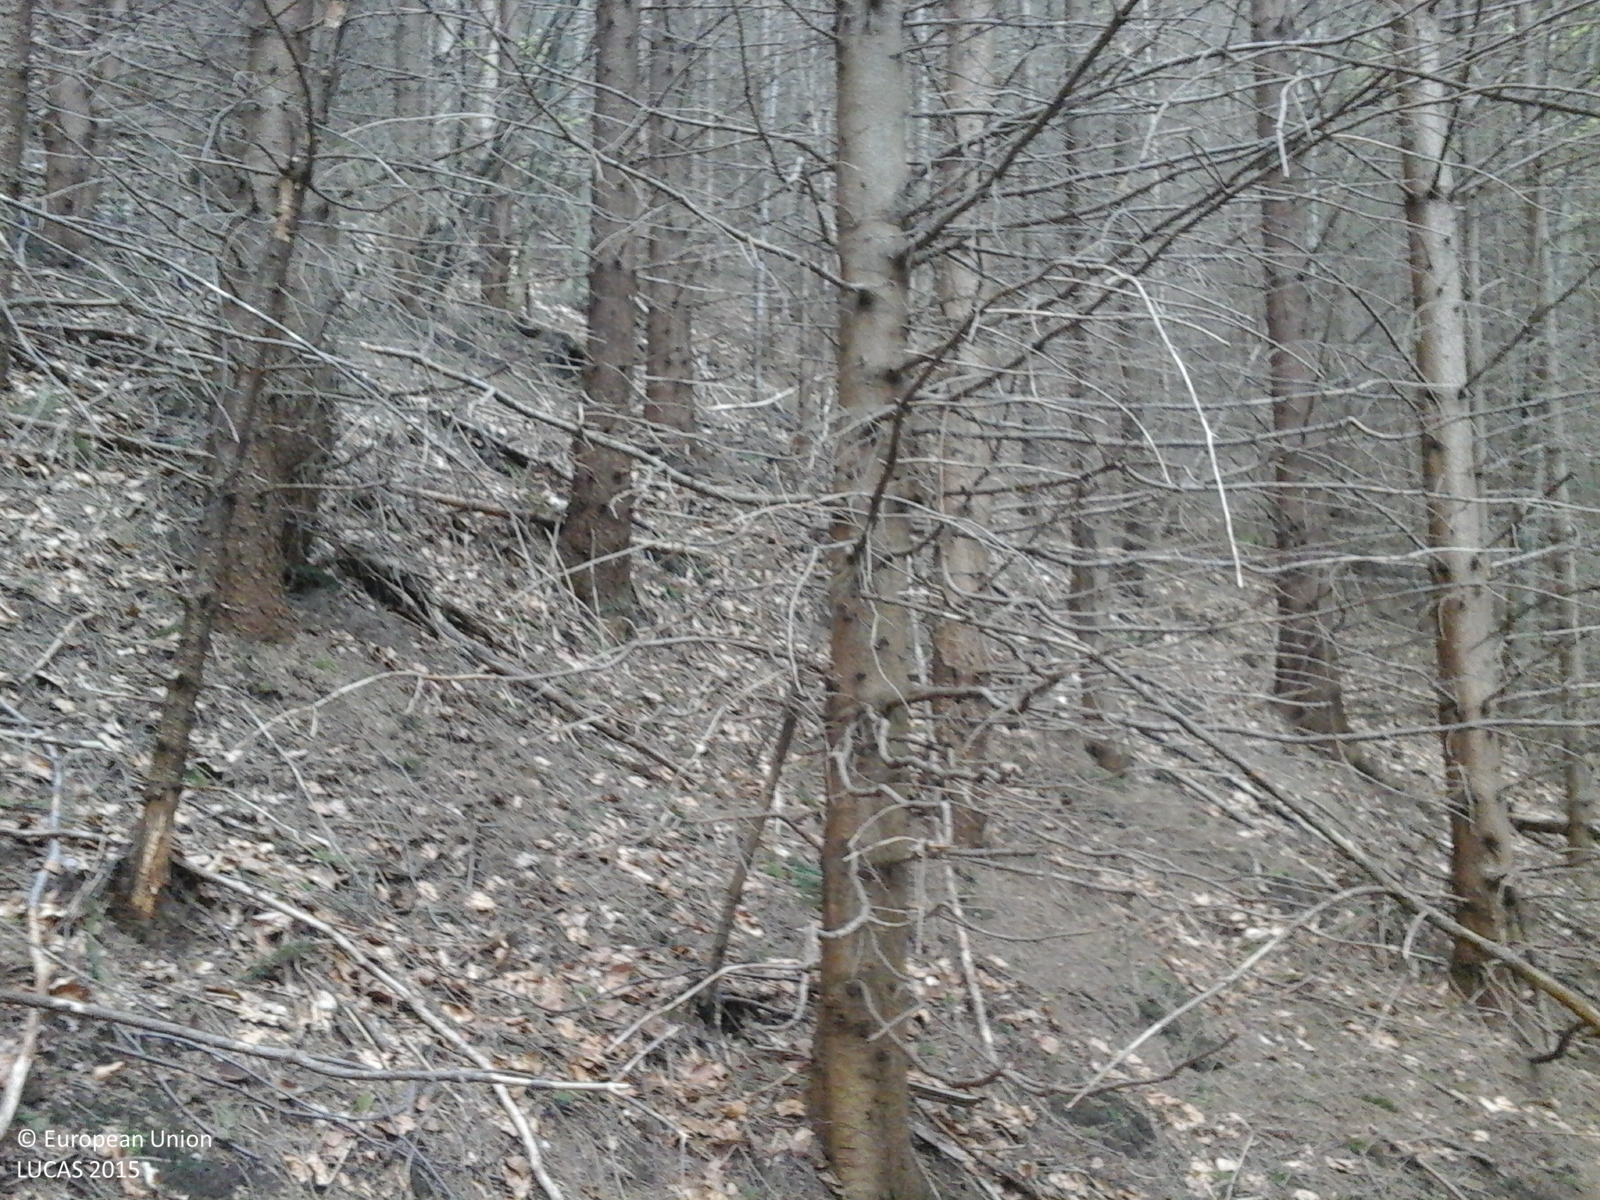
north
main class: Woodland
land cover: Spruce dominated mixed woodland
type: alpine coniferous forest
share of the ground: > 75 %
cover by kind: coniferous forest trees 50 %, broadleaved forest trees 50 %
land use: Forestry
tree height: > 5 m
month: May
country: RO
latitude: 45.5686
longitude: 25.9362
